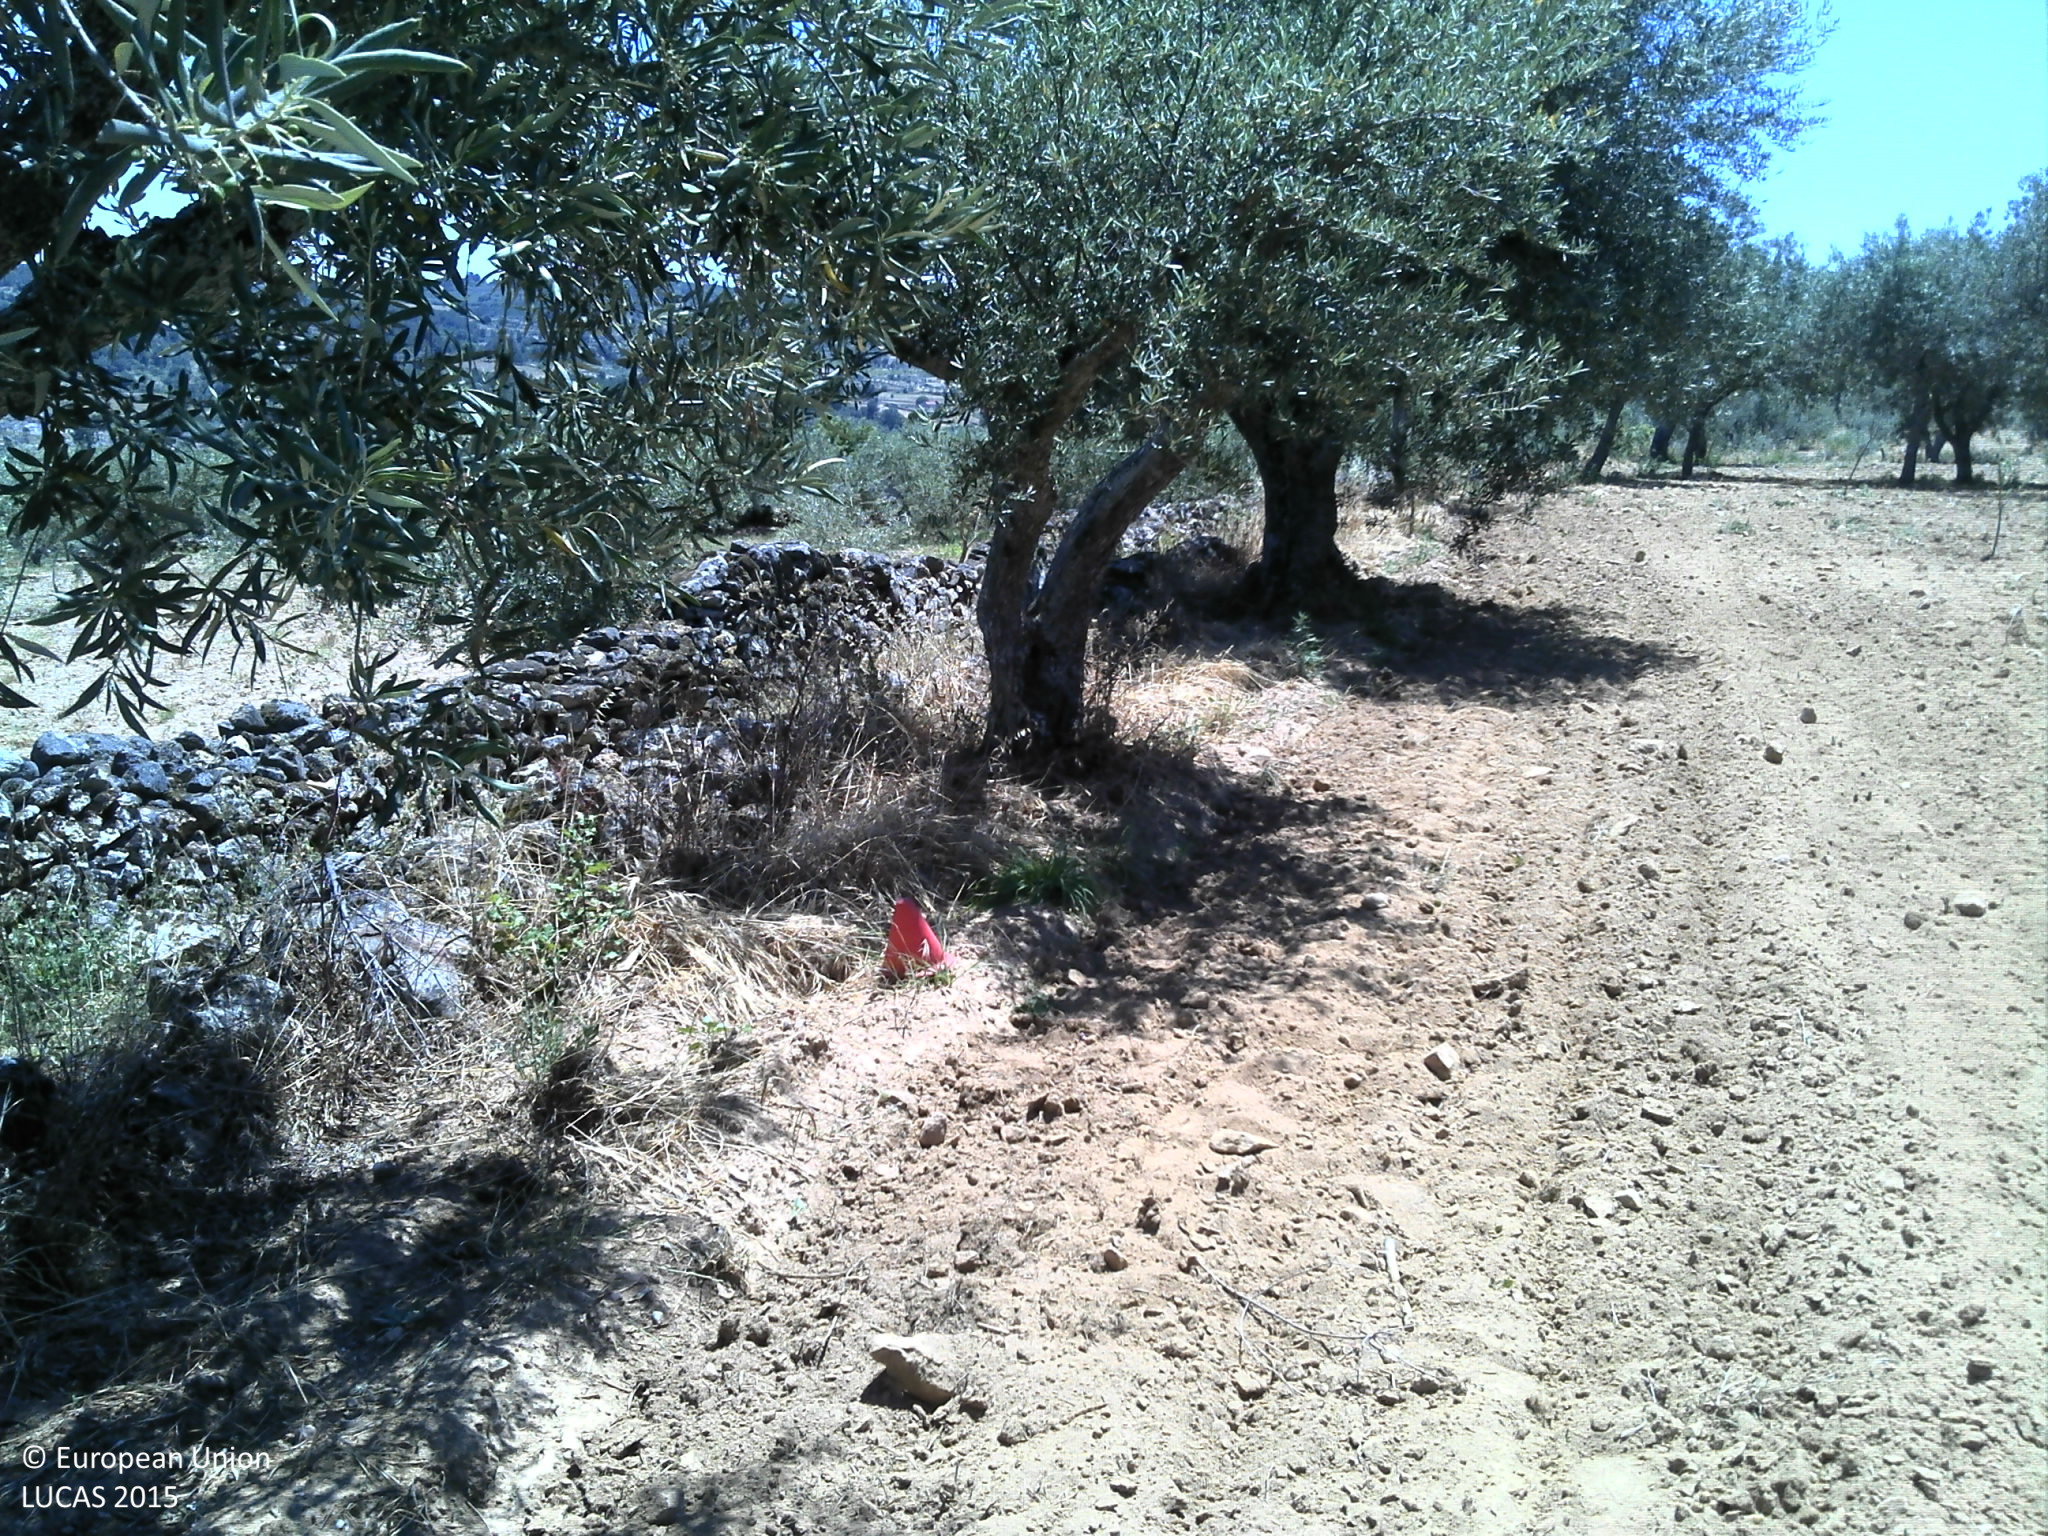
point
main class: Cropland
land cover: Olive groves
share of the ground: 25 - 50 %
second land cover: Other bare soil
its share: > 75 %
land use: Agriculture (excluding fallow land and kitchen gardens)
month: June
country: PT
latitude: 40.8041
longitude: -7.2864
